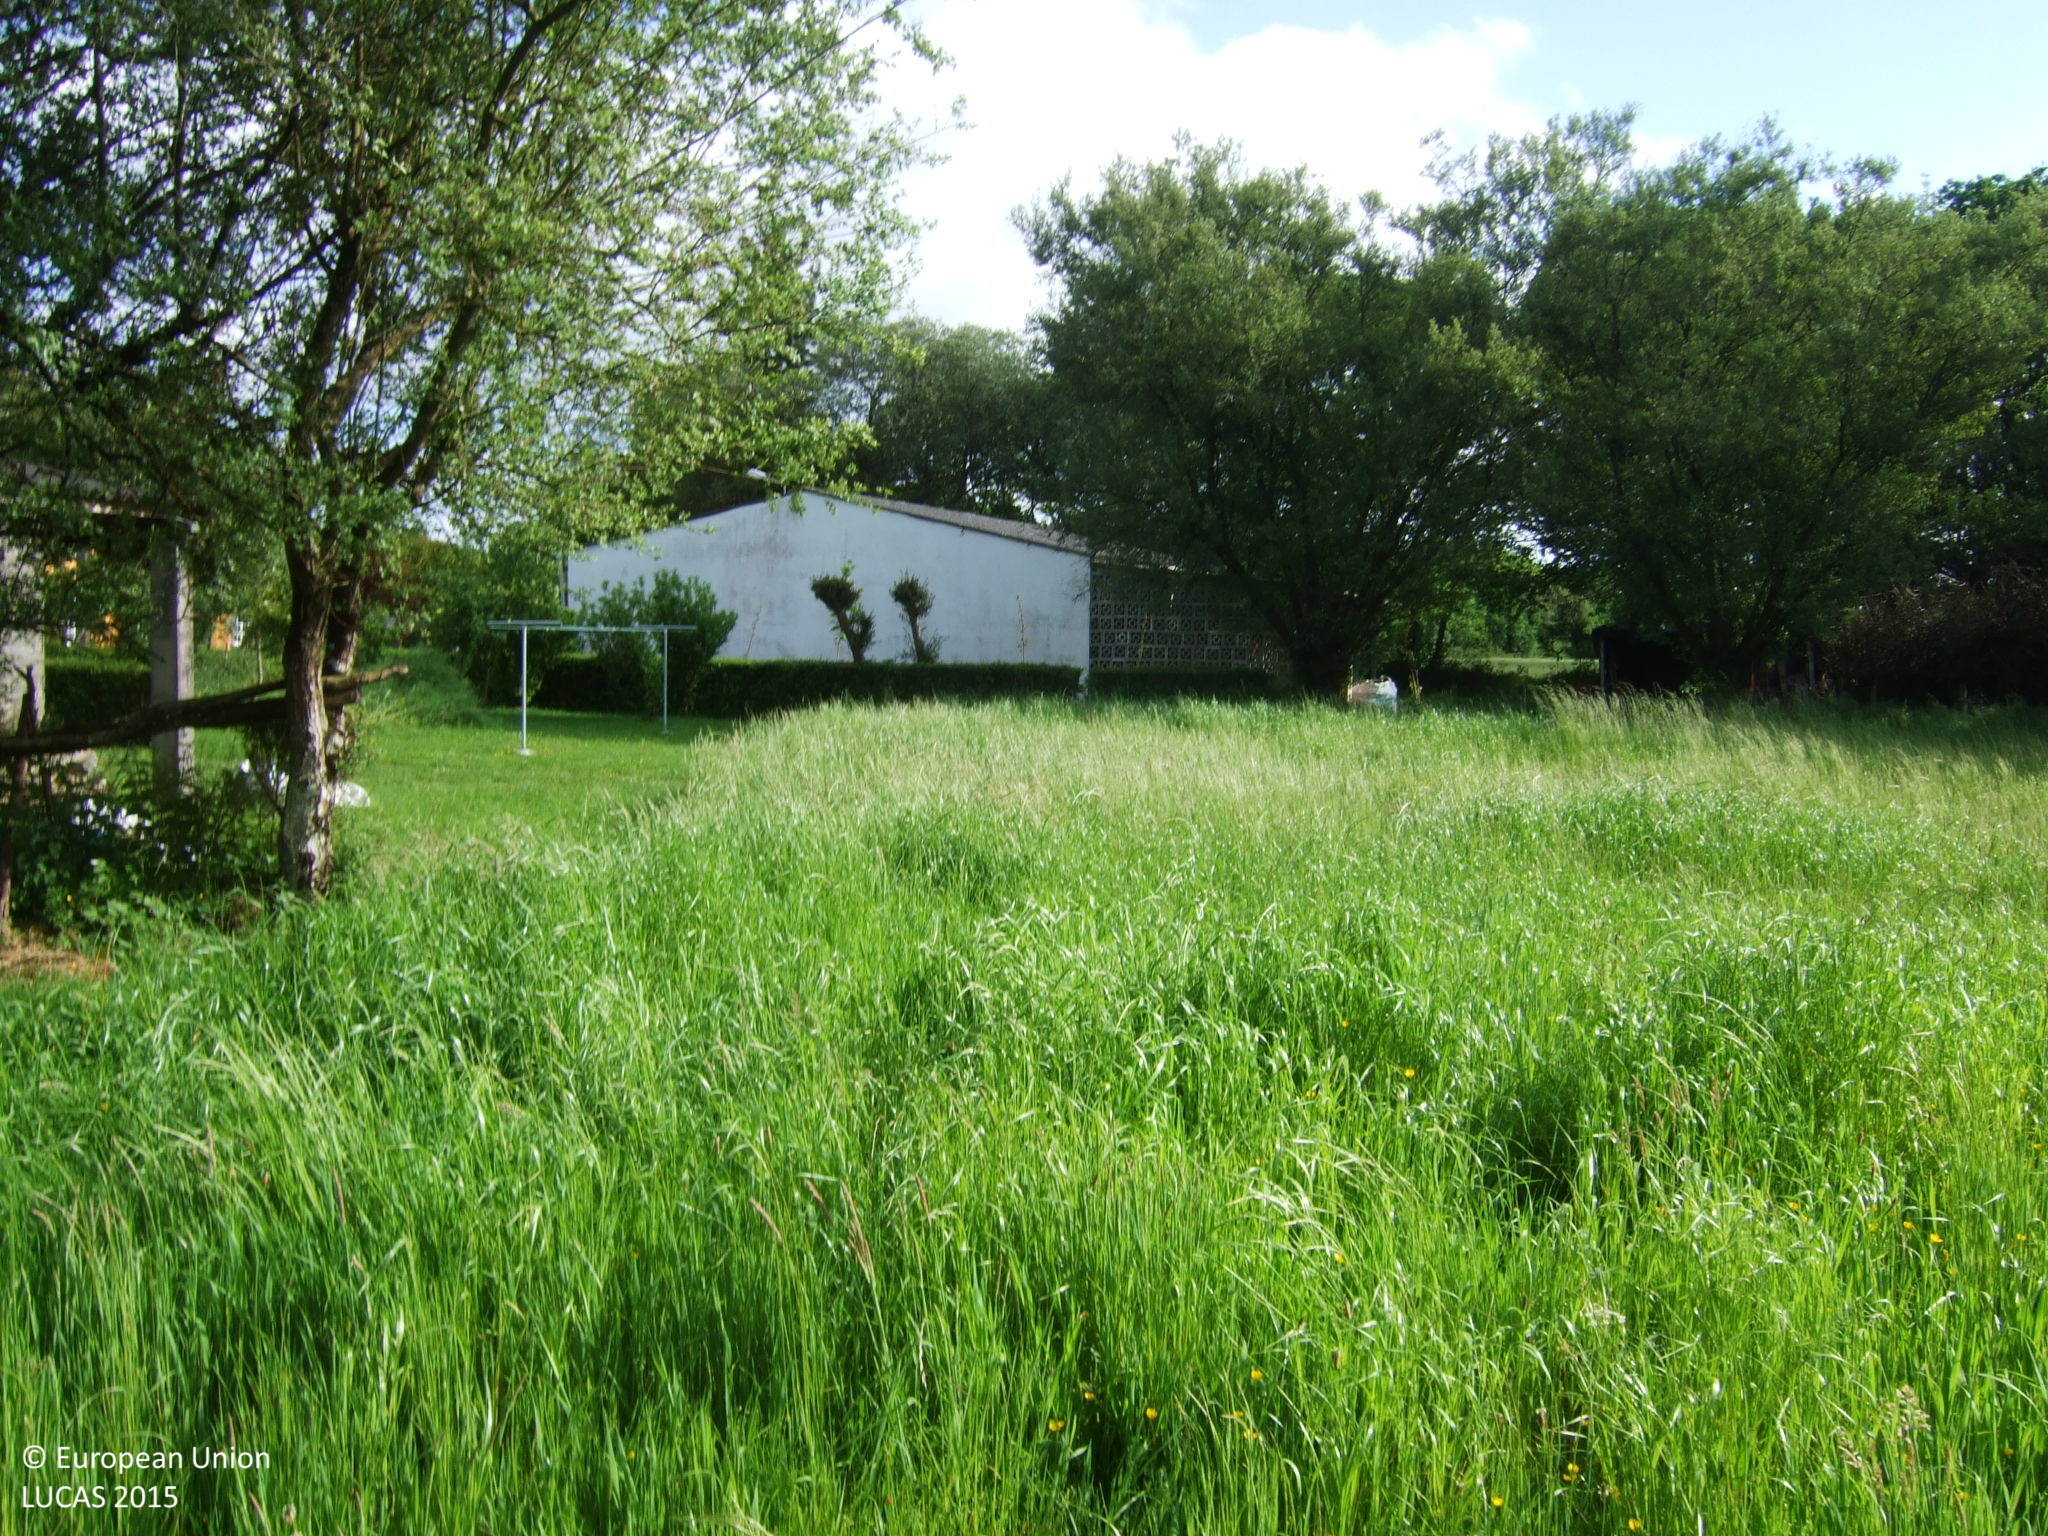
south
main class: Grassland
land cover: Grassland without tree/shrub cover
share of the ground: > 75 %
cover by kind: herbaceous plants 100 %
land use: Agriculture (excluding fallow land and kitchen gardens)
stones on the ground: < 10 %
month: May
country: ES
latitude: 43.1873
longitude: -7.4626
